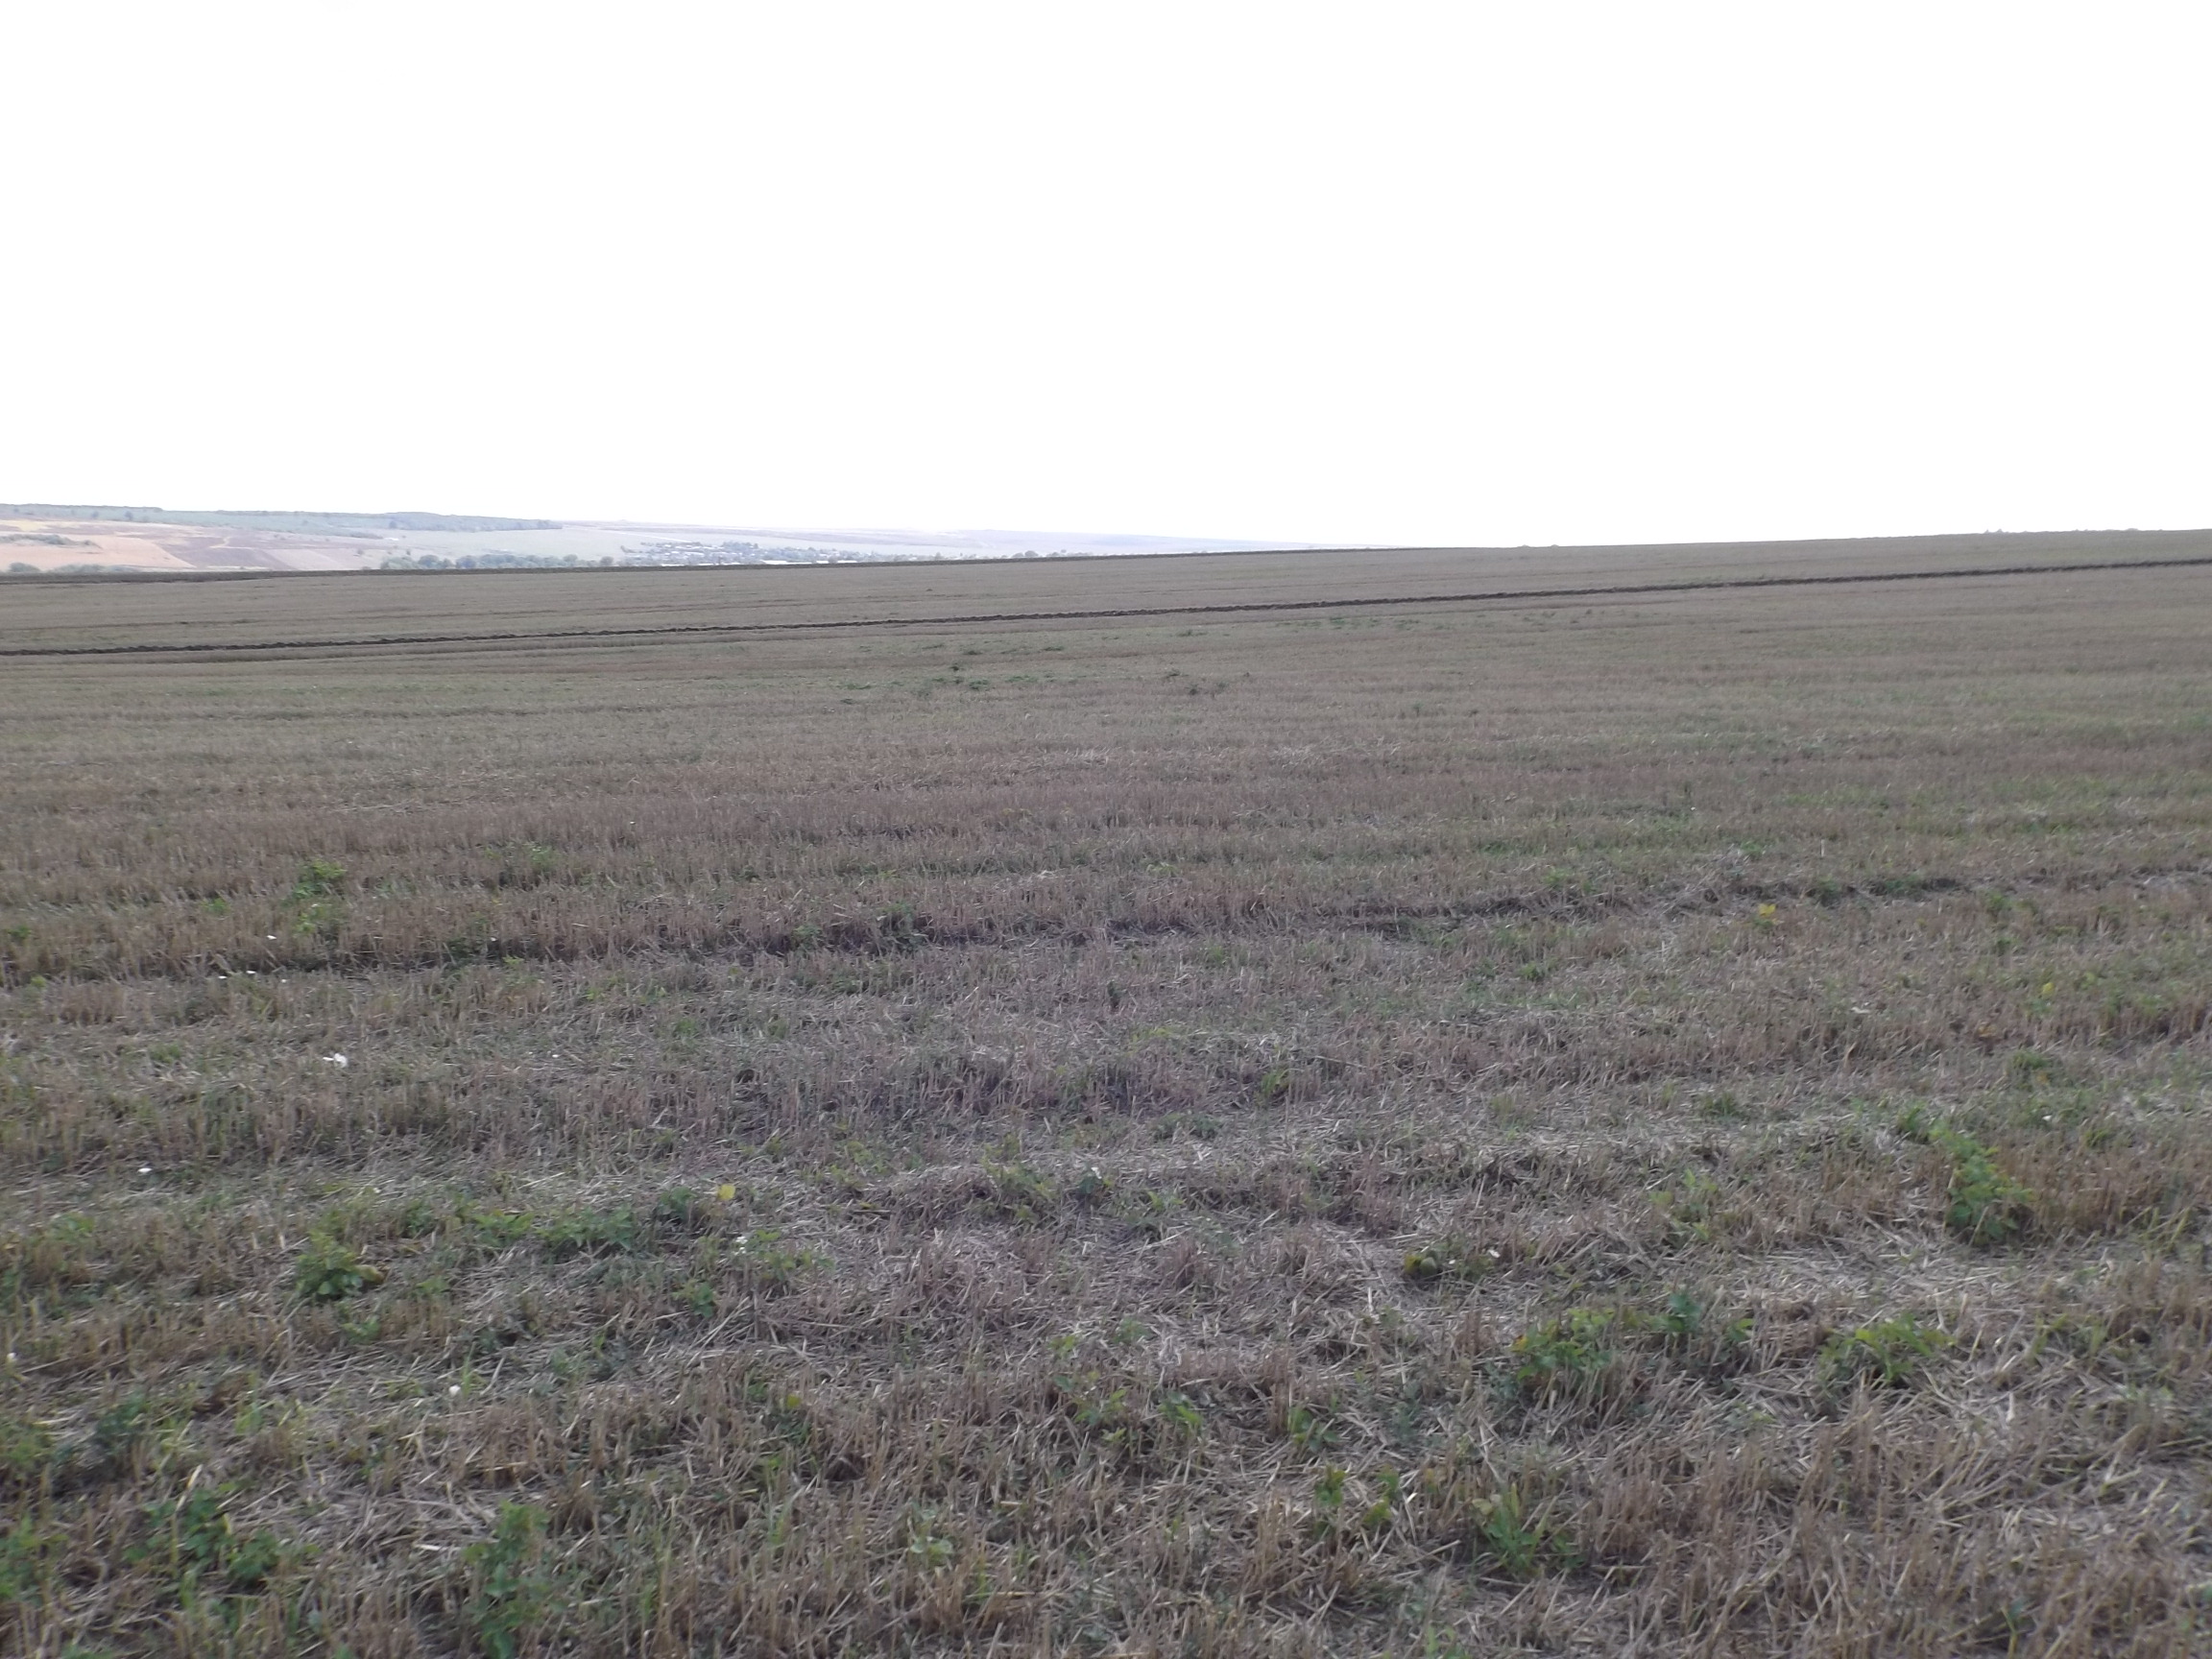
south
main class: Cropland
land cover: Common wheat
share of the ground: < 10 %
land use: Agriculture (excluding fallow land and kitchen gardens)
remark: Harvested field
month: August
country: BG
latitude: 43.4273
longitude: 27.4598
